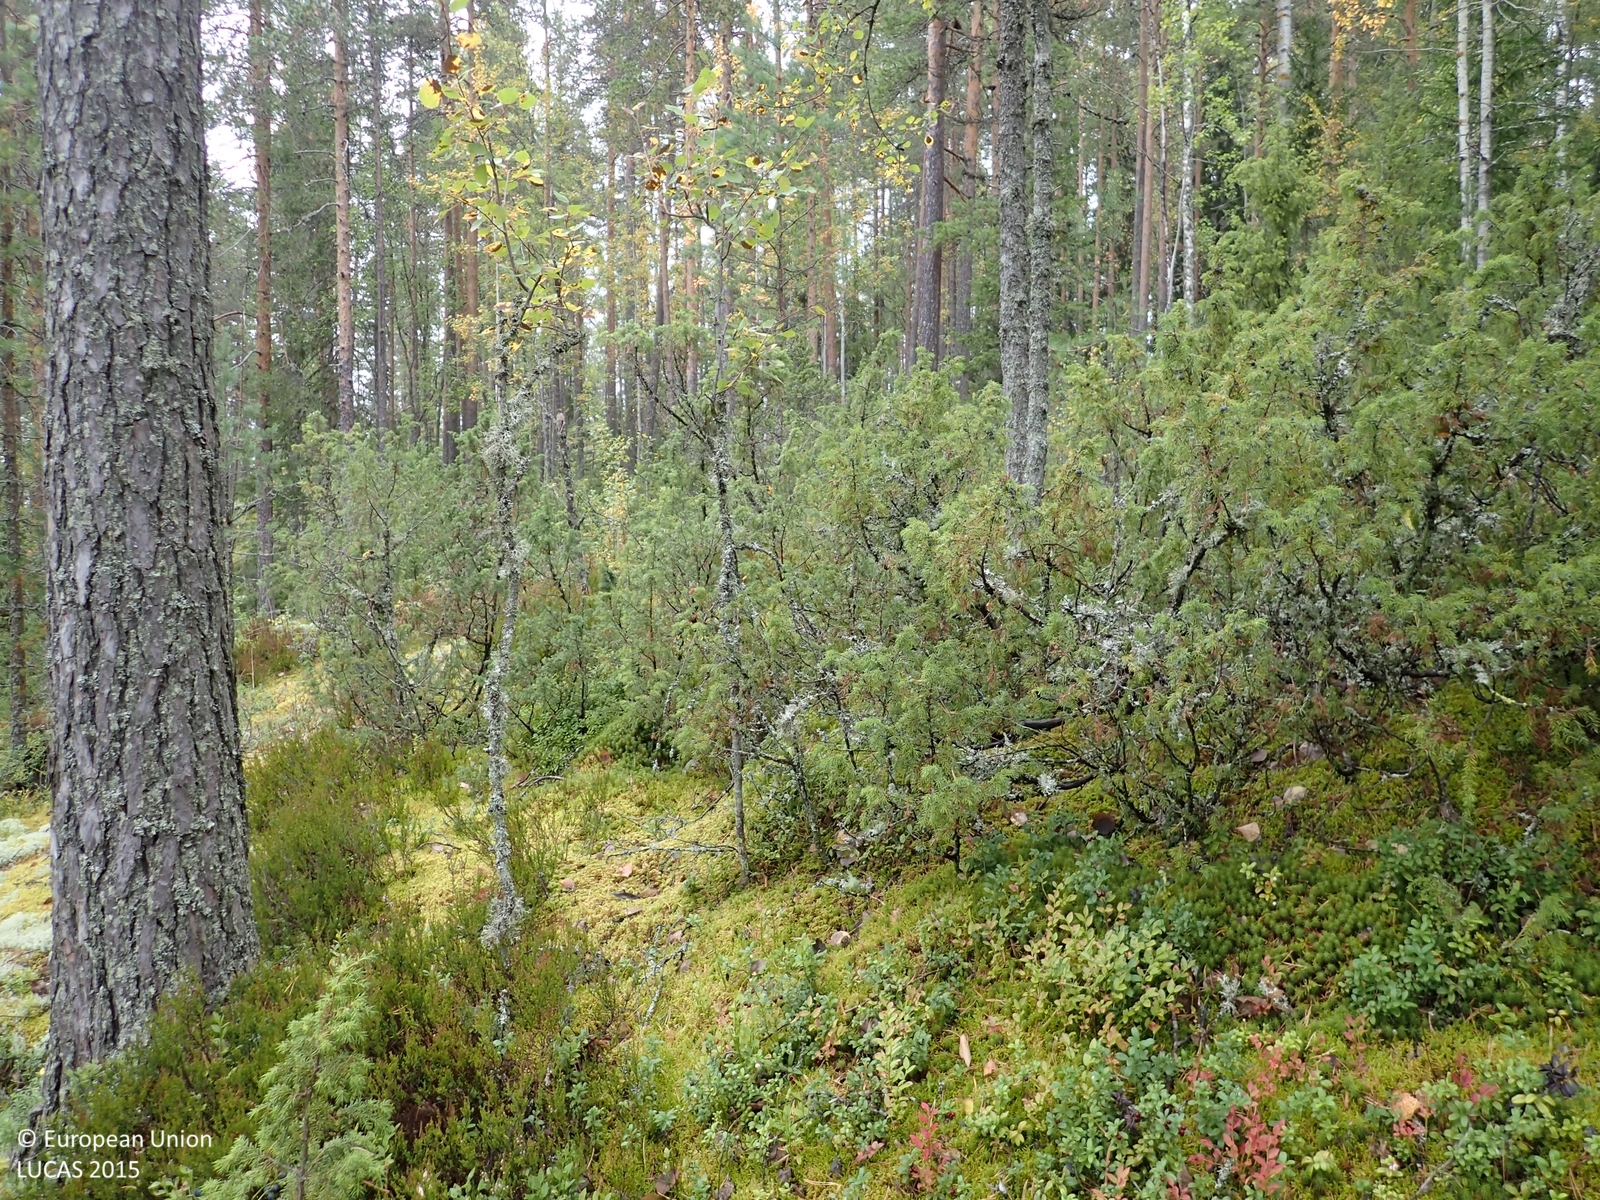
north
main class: Woodland
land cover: Pine dominated mixed woodland
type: boreal forest
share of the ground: > 75 %
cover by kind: coniferous forest trees 55 %, broadleaved forest trees 20 %, lichens and mosses 15 %, shrubs 10 %
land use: Forestry
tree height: > 5 m
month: September
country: FI
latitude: 63.0650
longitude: 25.6022
